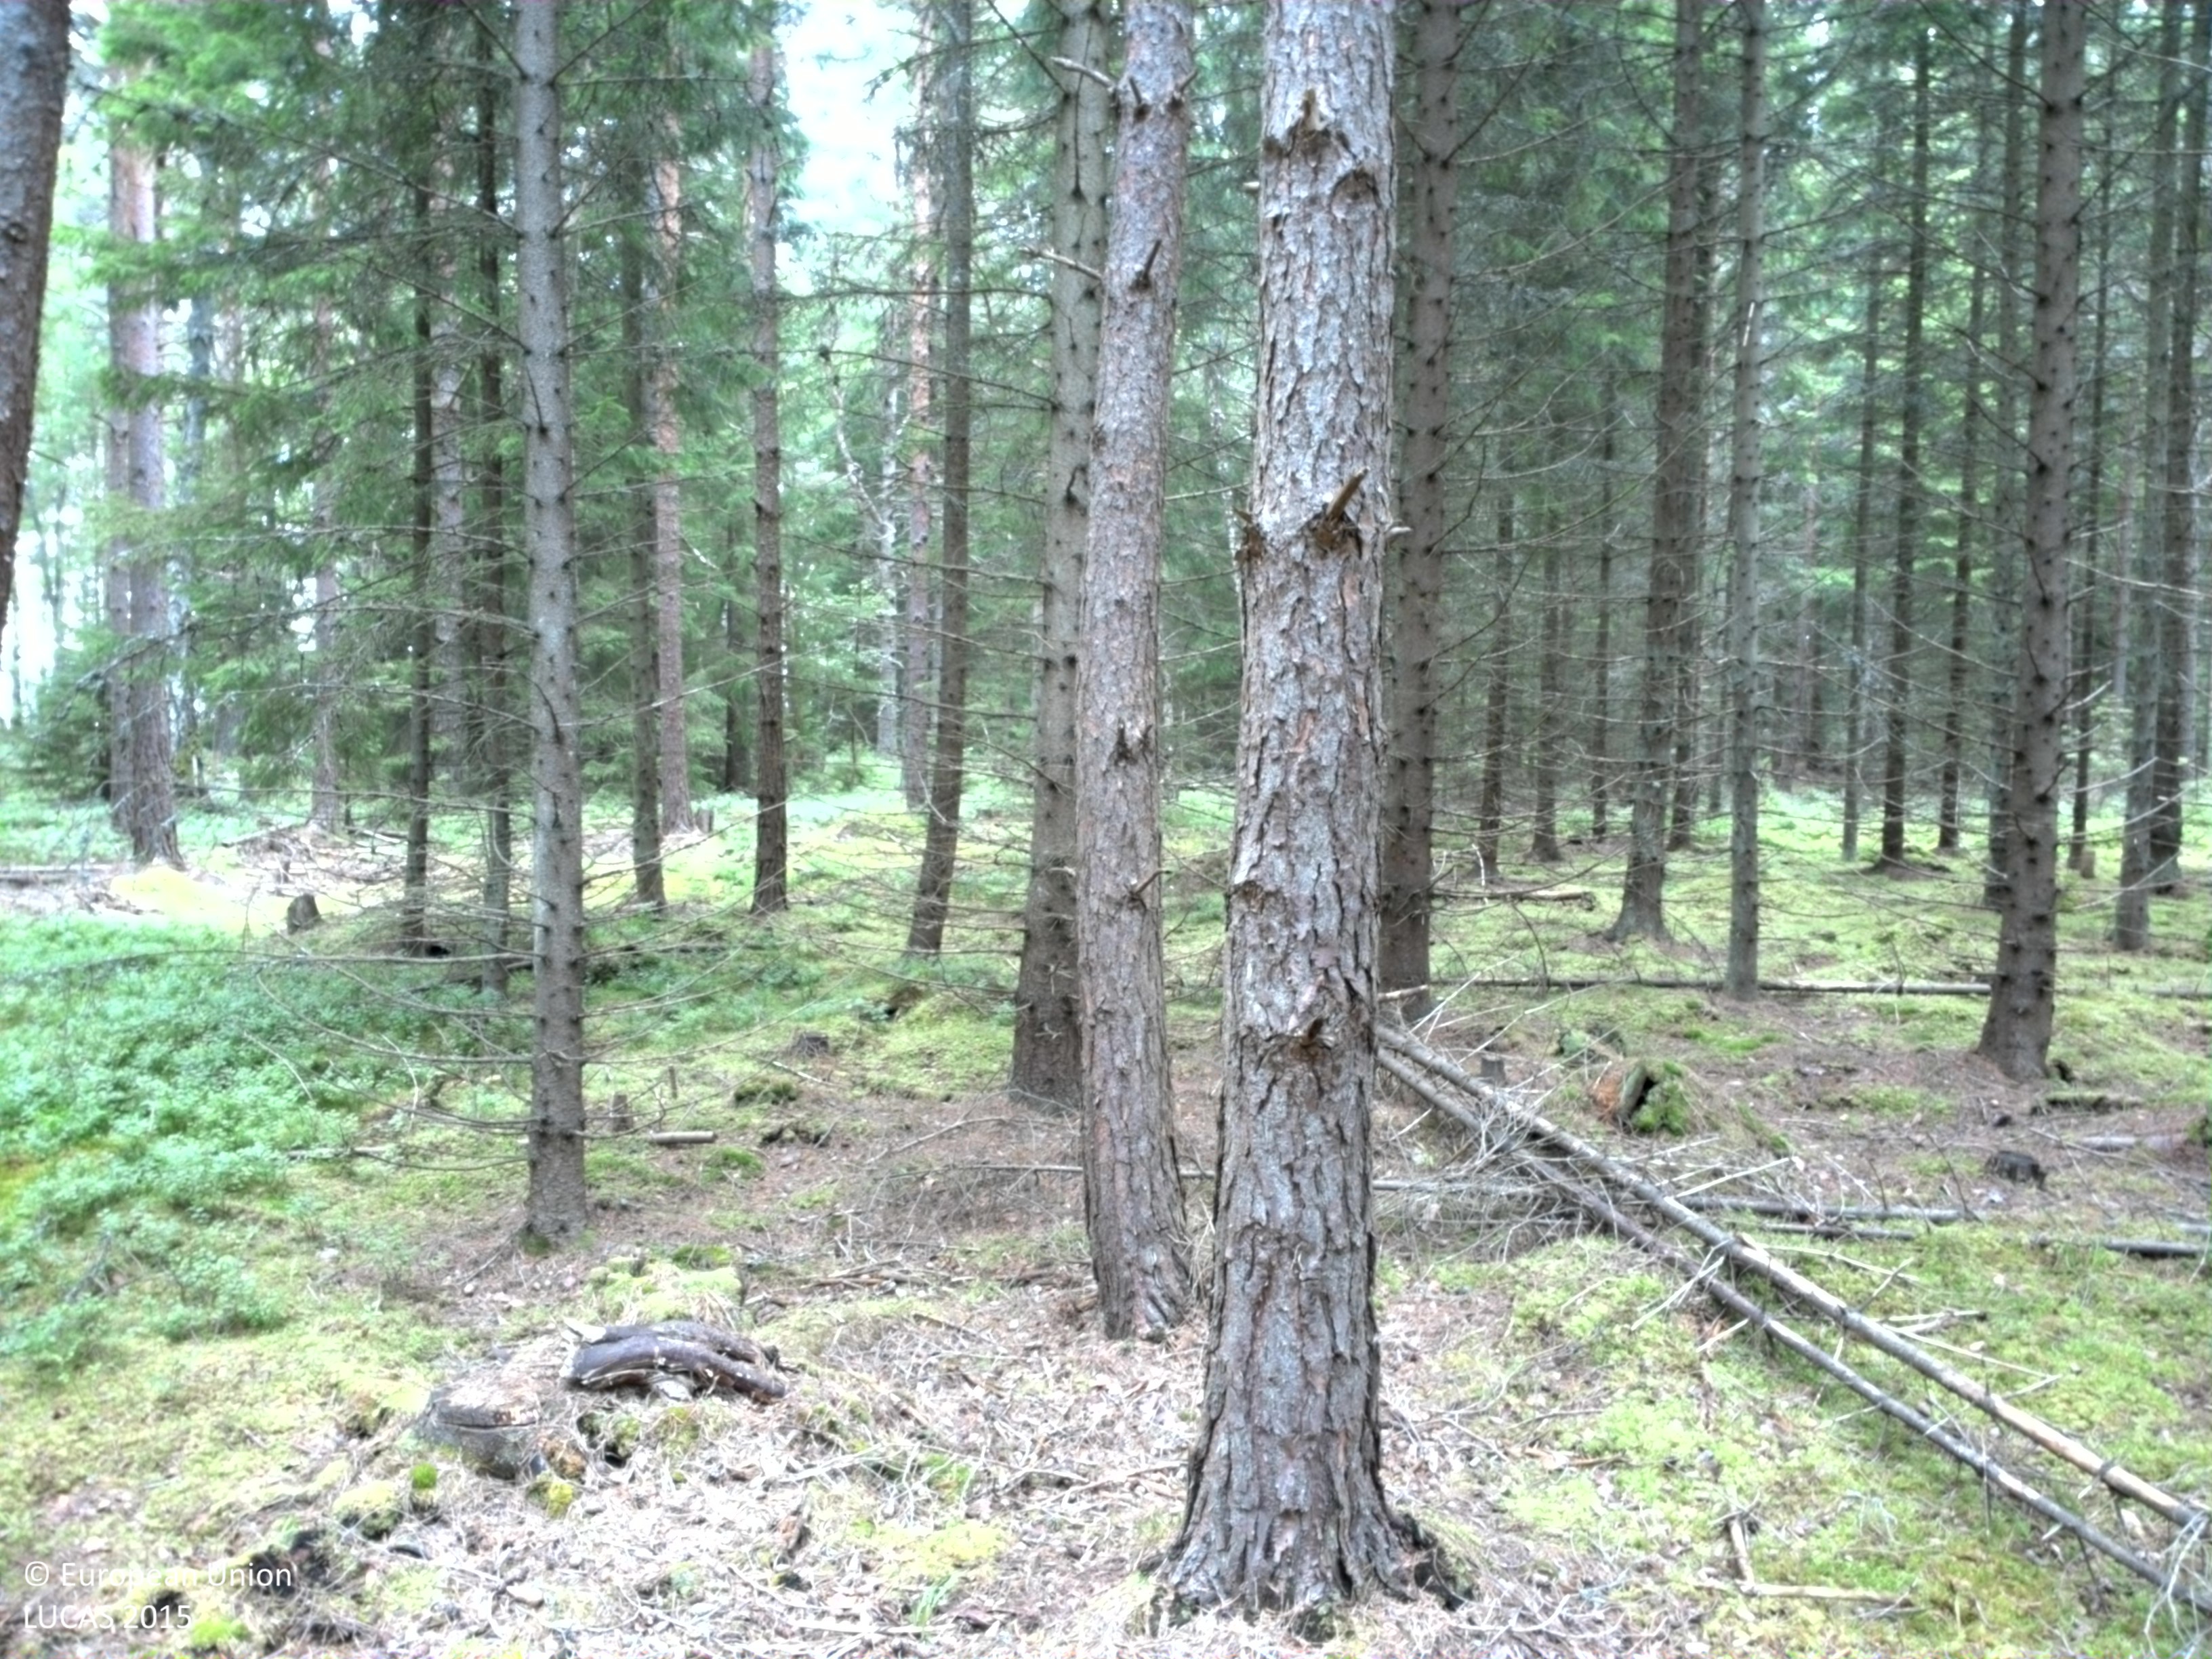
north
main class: Woodland
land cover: Spruce dominated coniferous woodland
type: boreal forest
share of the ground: 50 - 75 %
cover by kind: coniferous forest trees 75 %, lichens and mosses 25 %
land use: Forestry
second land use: Amenities, museums, leisure
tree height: > 5 m
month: July
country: SE
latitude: 58.6270
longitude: 13.3864
